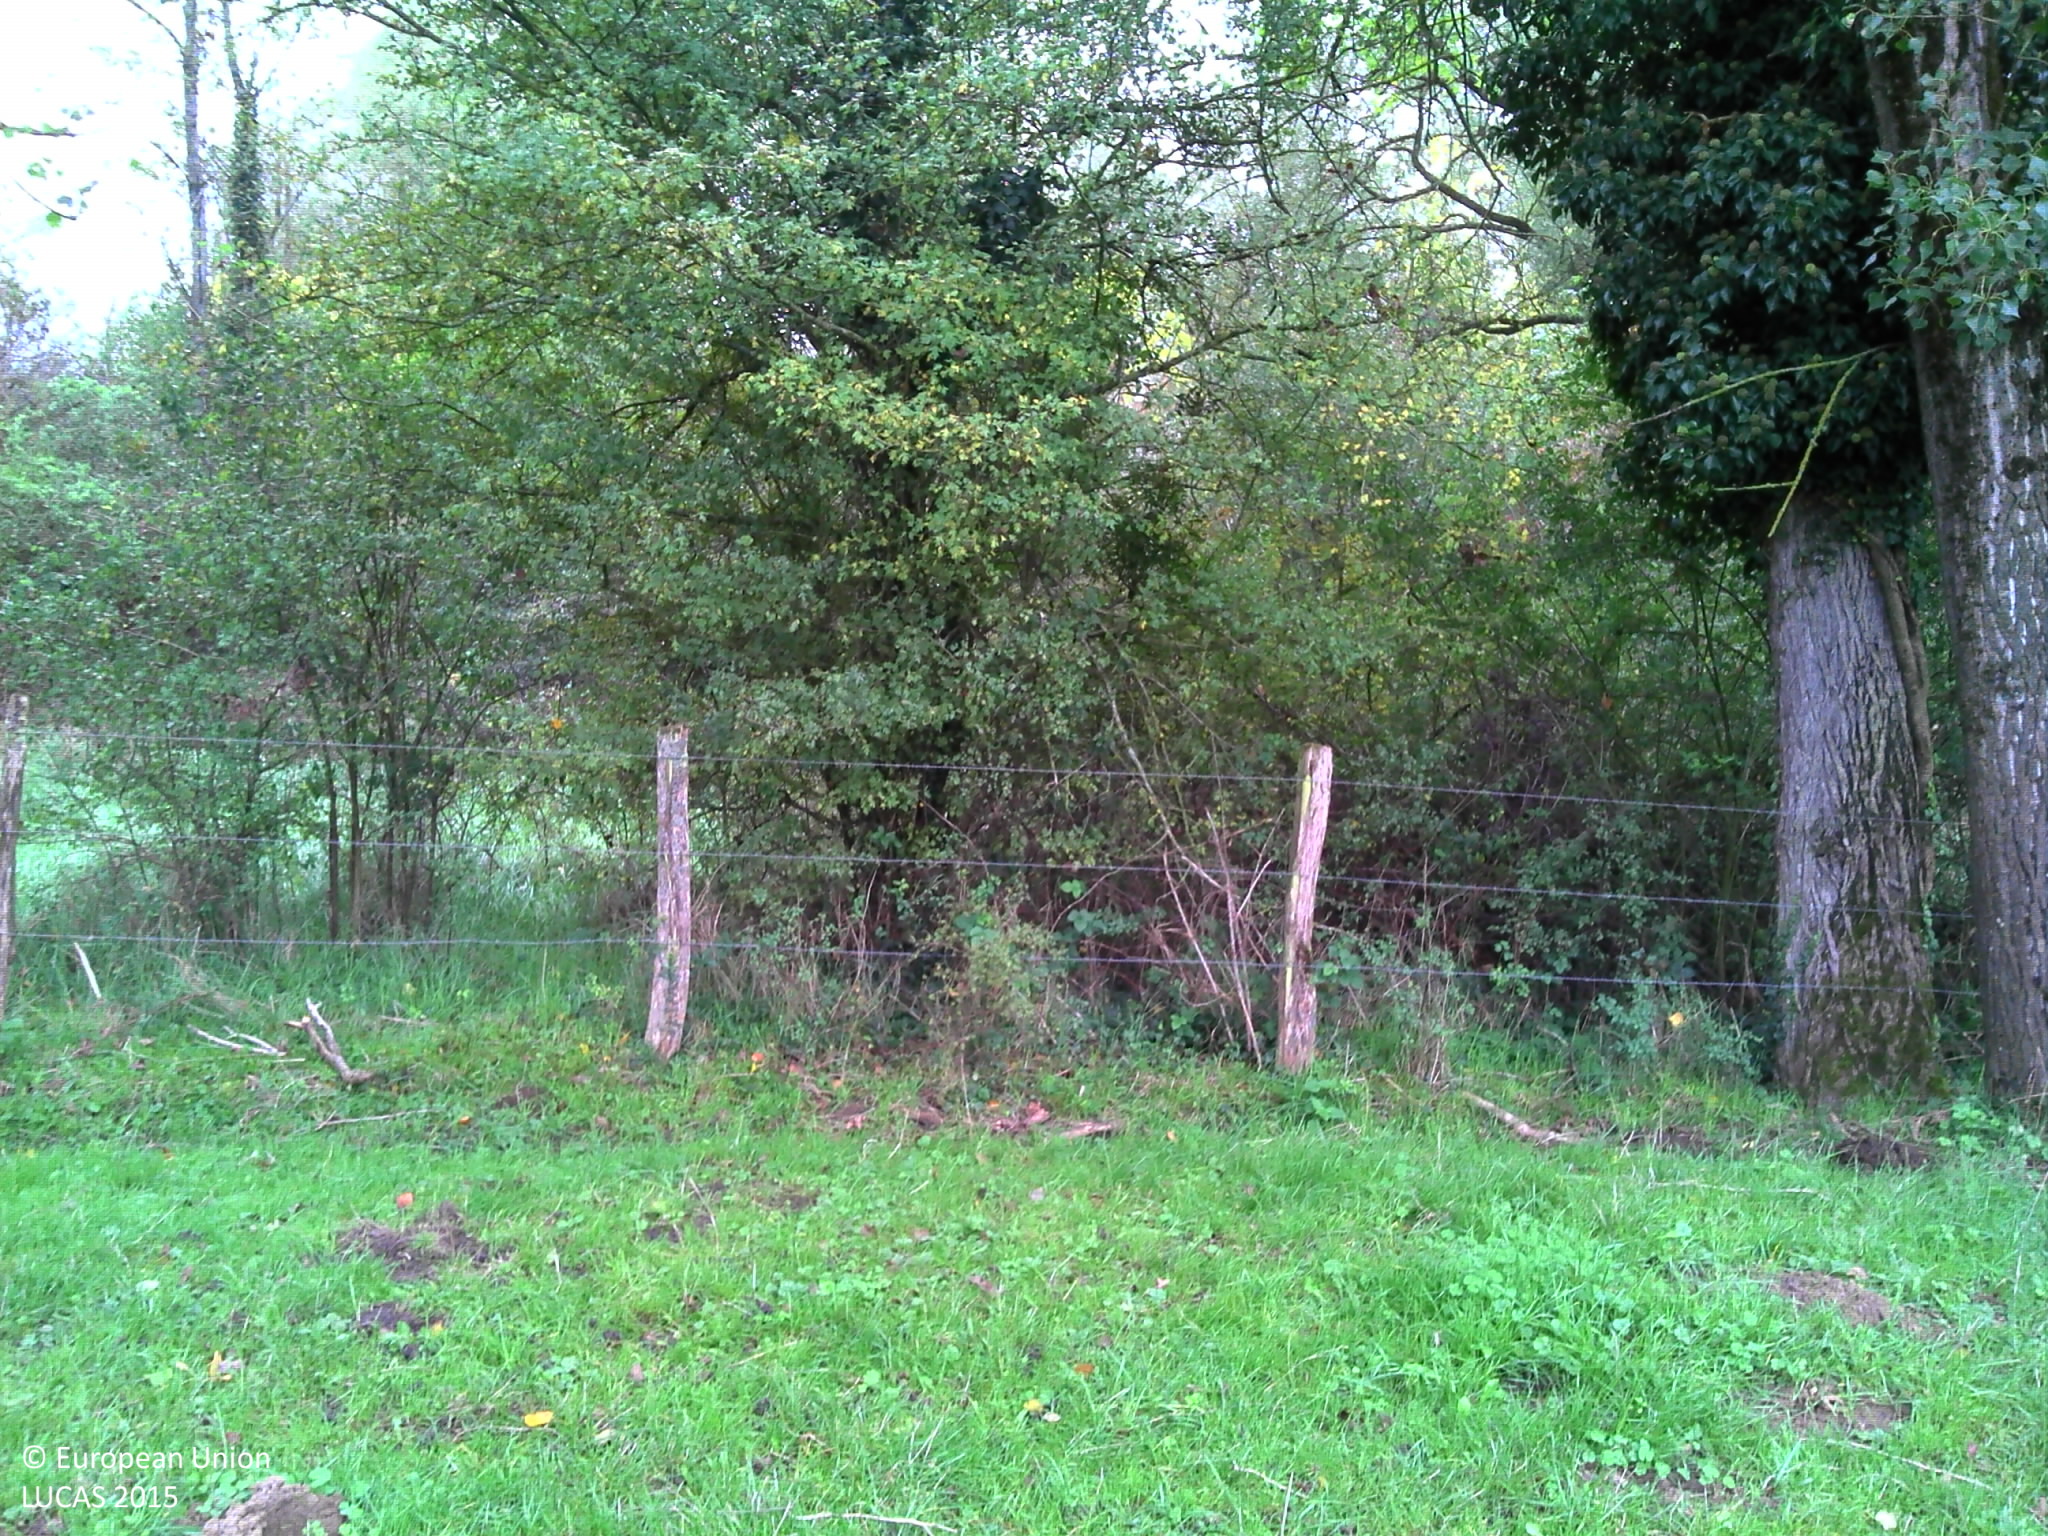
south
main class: Grassland
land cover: Grassland with sparse tree/shrub cover
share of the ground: > 75 %
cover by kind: herbaceous plants 95 %, broadleaved forest trees 5 %
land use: Agriculture (excluding fallow land and kitchen gardens)
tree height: > 5 m
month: October
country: FR
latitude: 45.9295
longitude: 3.3845
